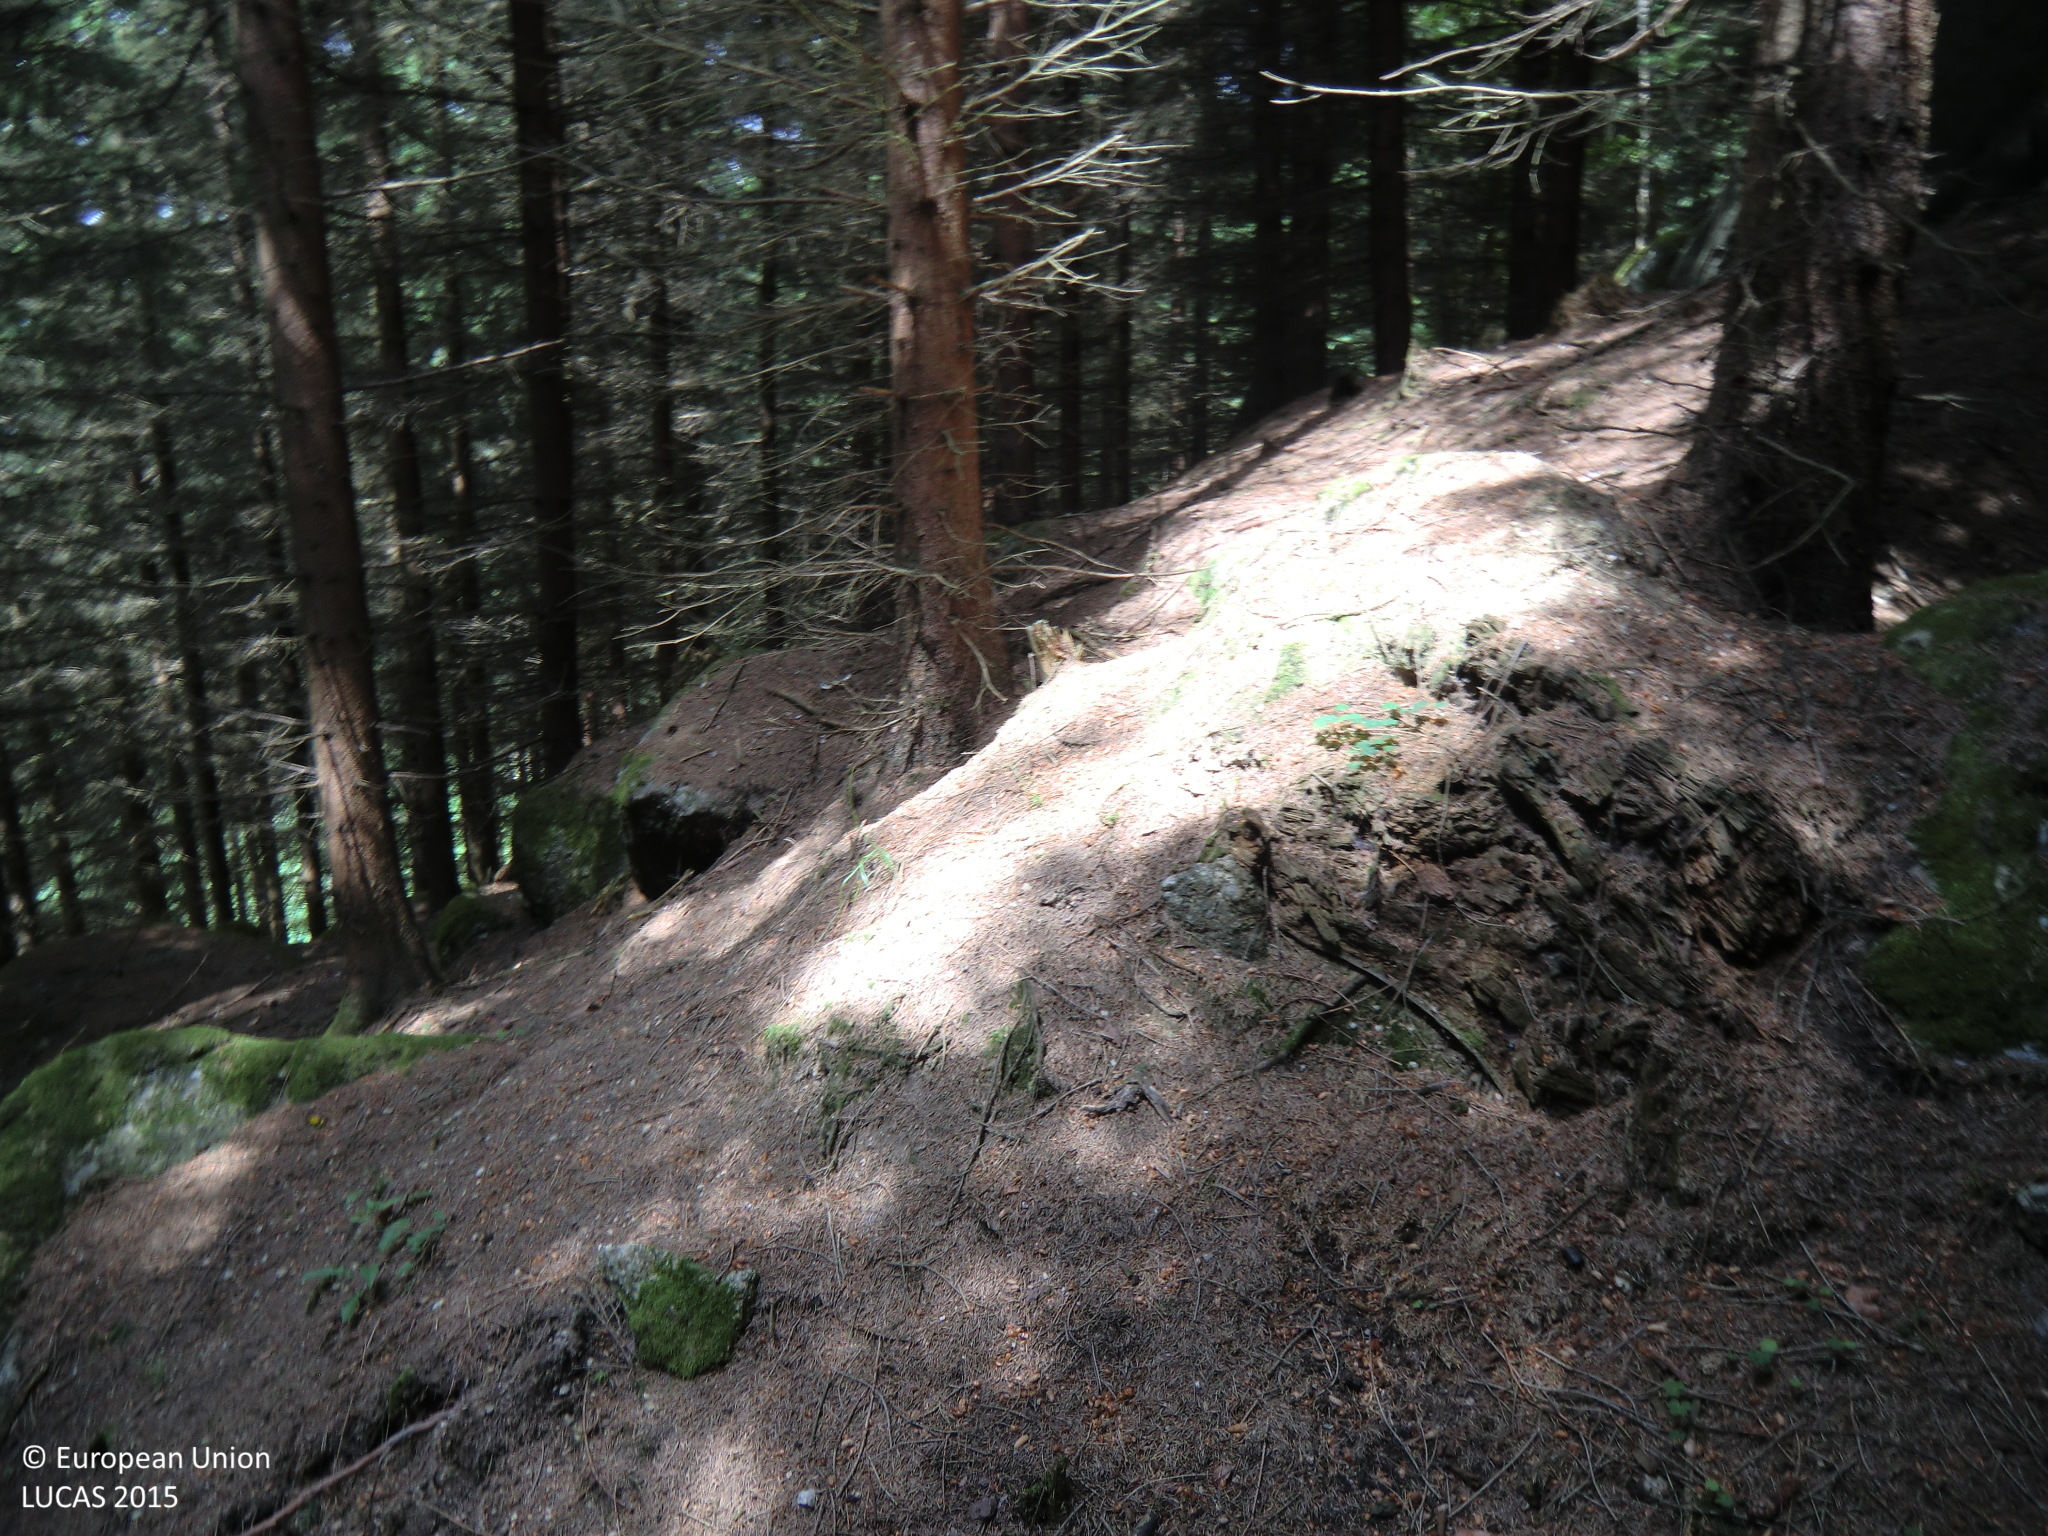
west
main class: Woodland
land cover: Spruce dominated coniferous woodland
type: hemiboreal forest and nemoral coniferous forest and mixed broadleaved-coniferous forest
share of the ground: > 75 %
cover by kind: coniferous forest trees 90 %, unconsolidated bare surface 10 %
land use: Forestry
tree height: > 5 m
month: June
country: AT
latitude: 48.4255
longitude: 14.7986
